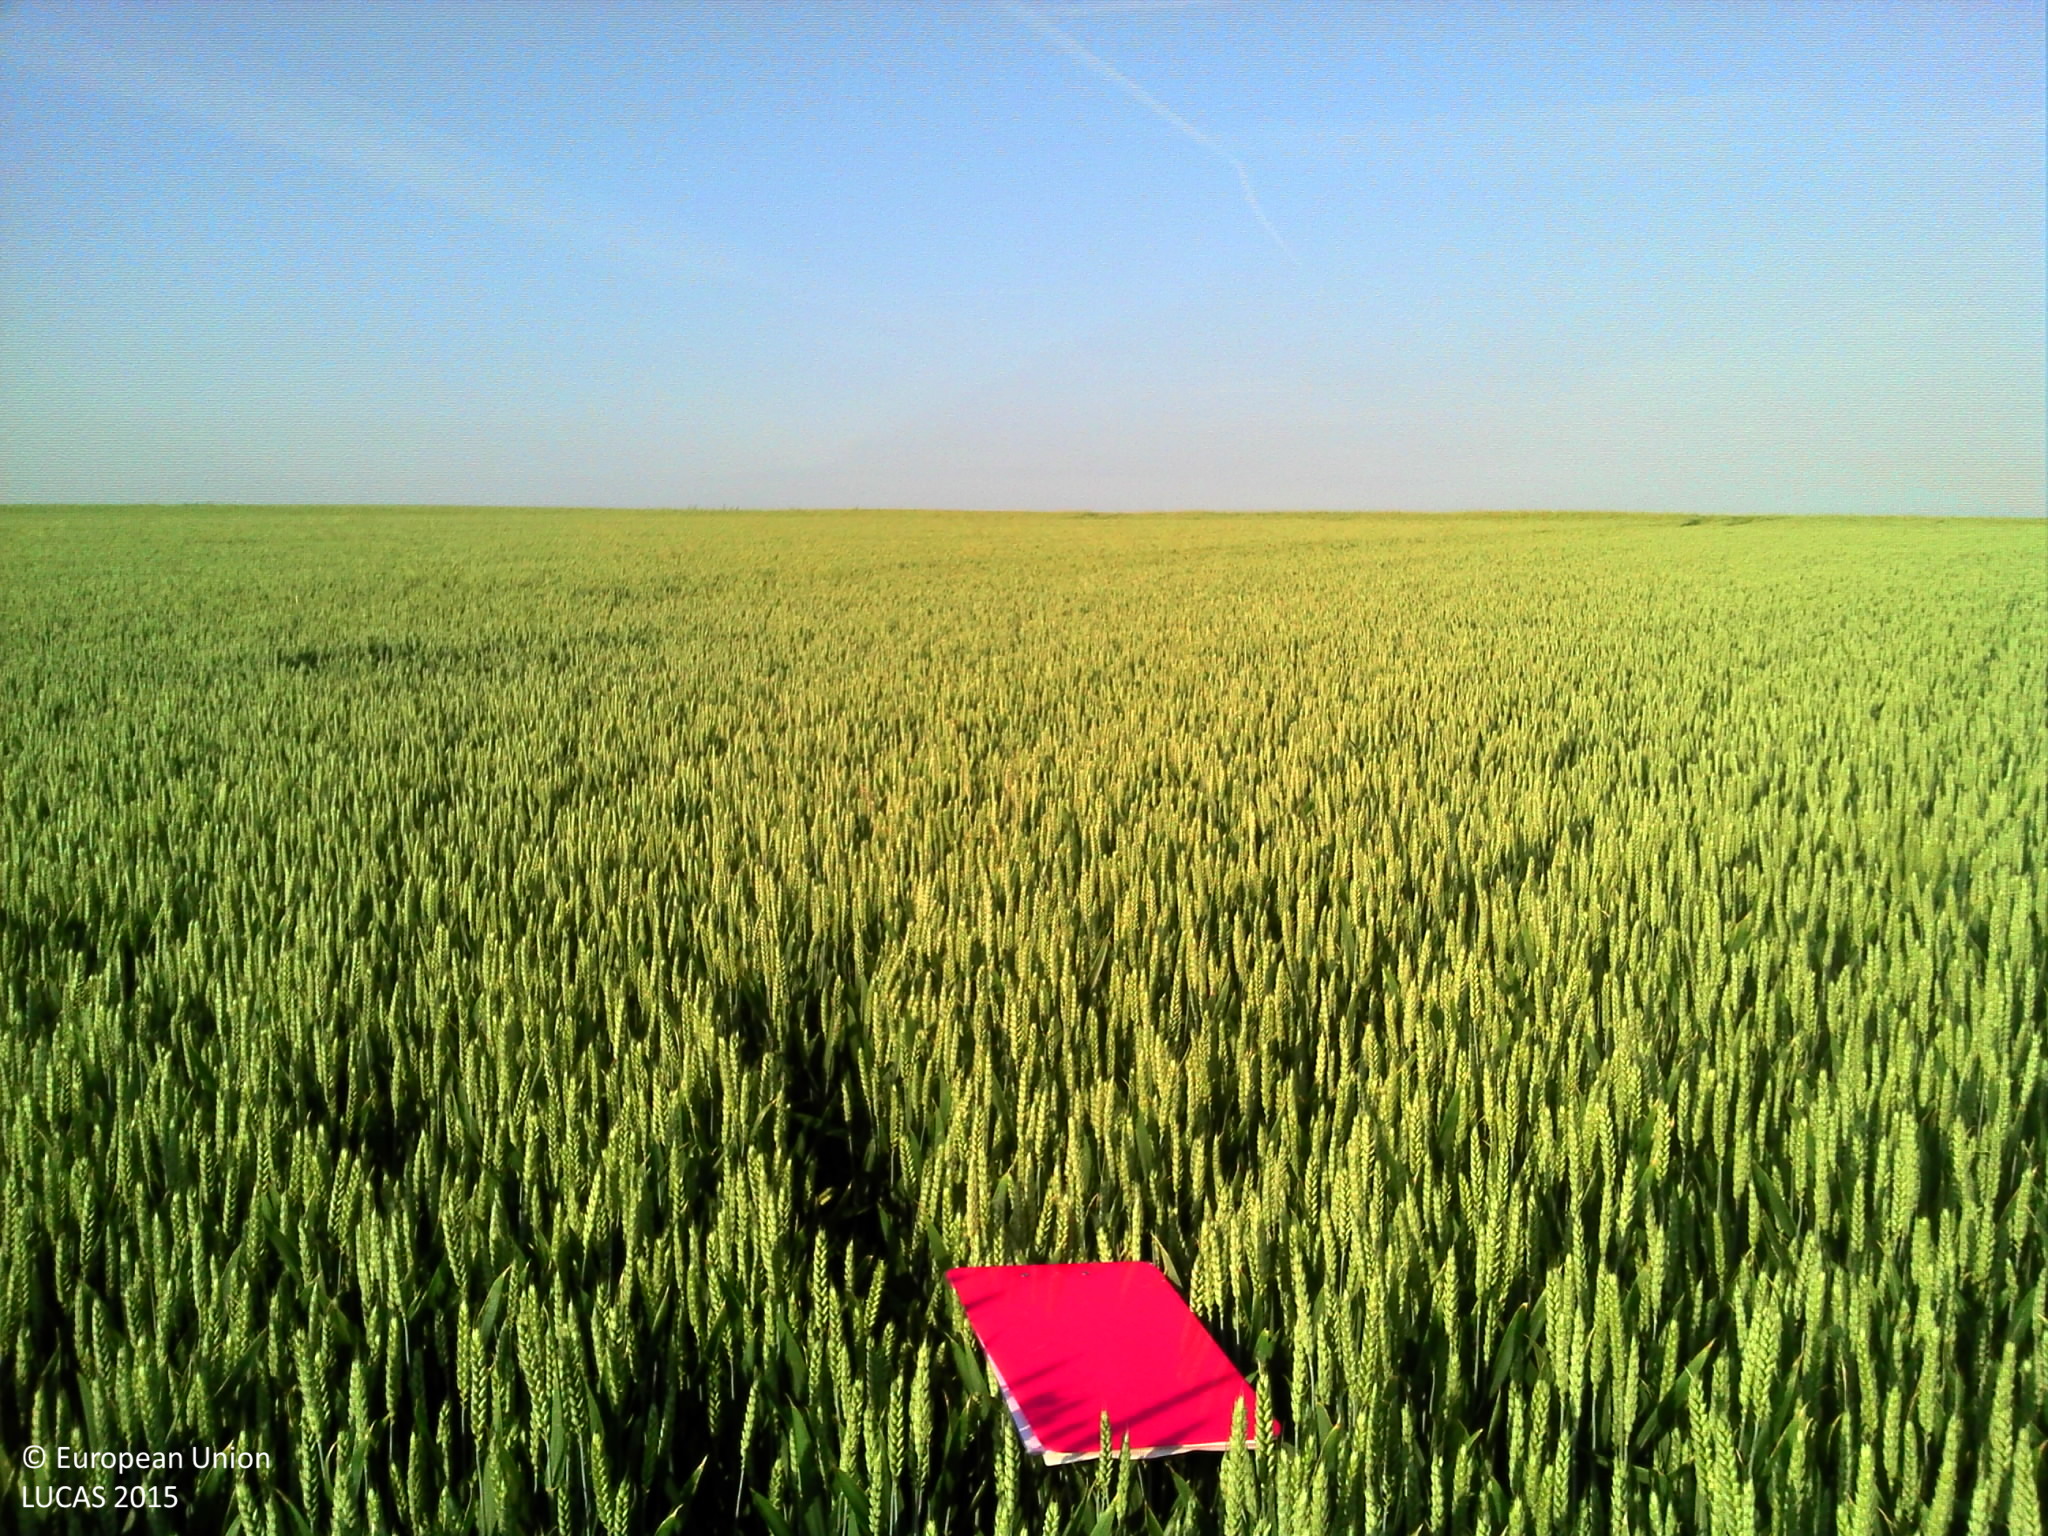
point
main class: Cropland
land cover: Common wheat
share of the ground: > 75 %
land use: Agriculture (excluding fallow land and kitchen gardens)
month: June
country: FR
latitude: 49.4350
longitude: 2.5557
